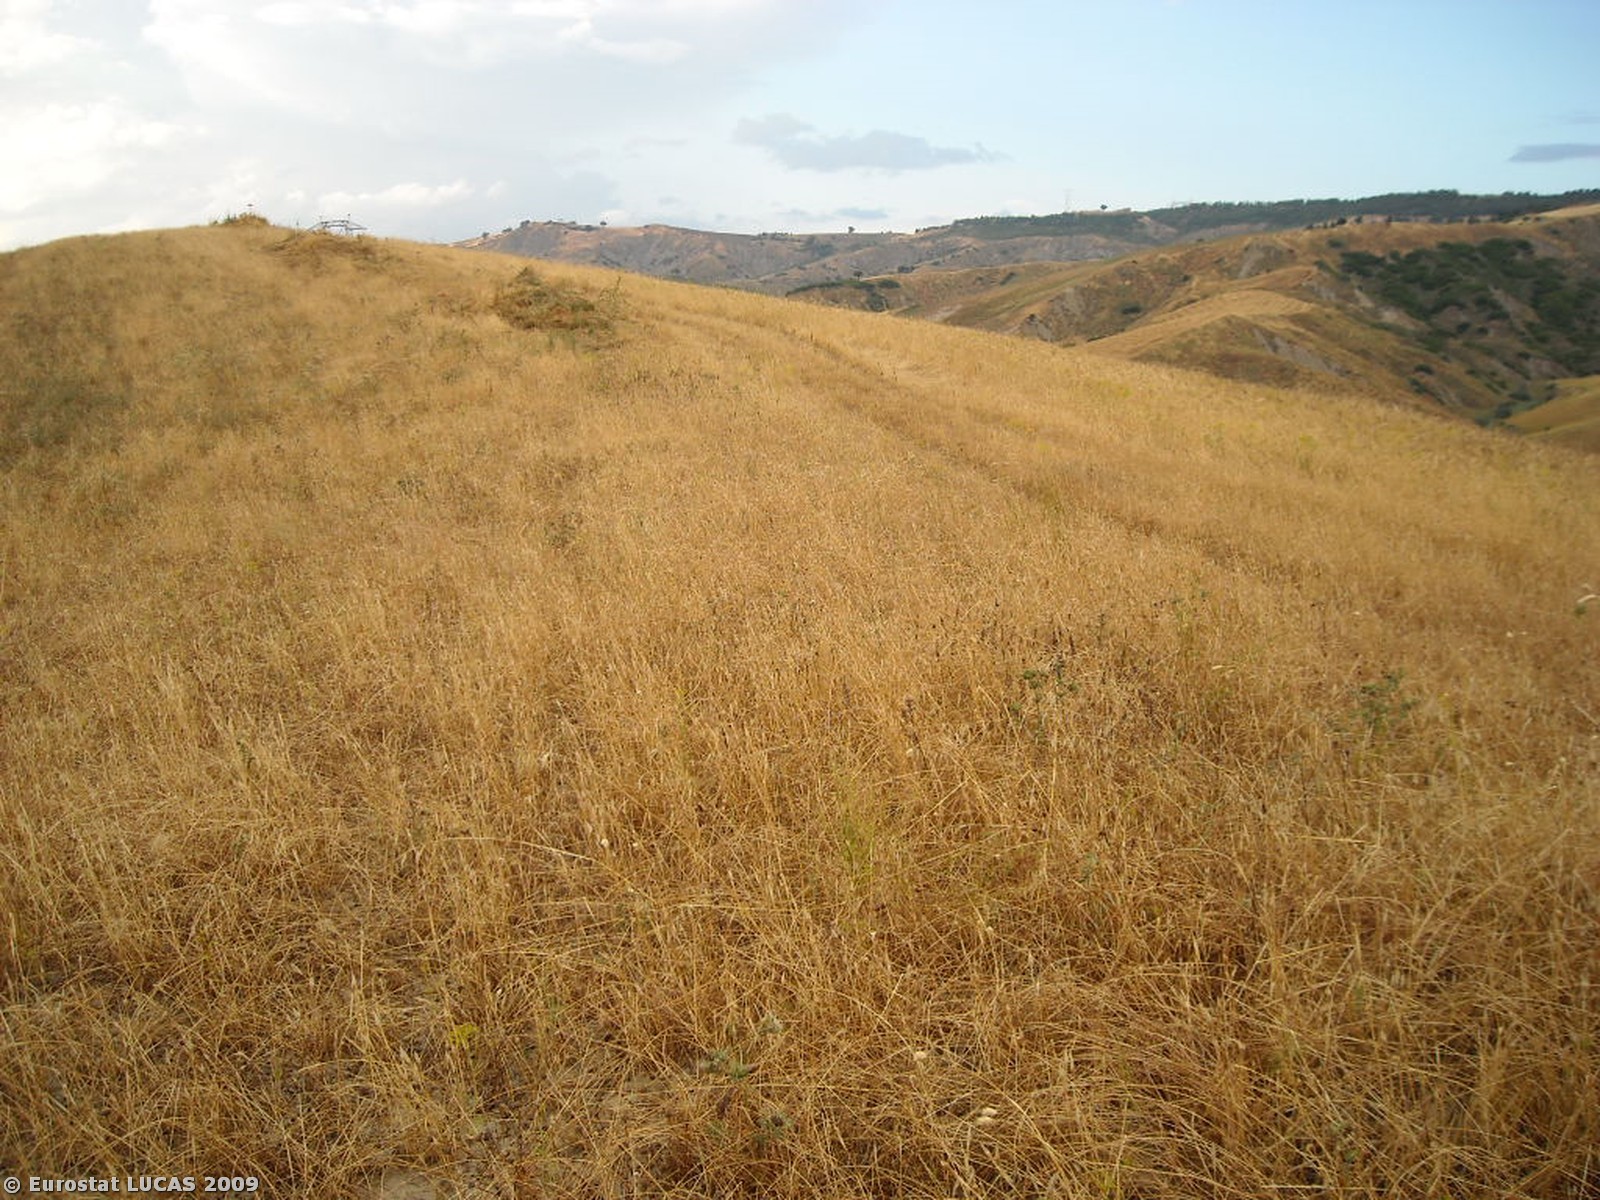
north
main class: Grassland
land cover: Spontaneously vegetated surfaces
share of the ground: > 75 %
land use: Fallow land
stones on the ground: < 10 %
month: June
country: IT
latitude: 40.5370
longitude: 16.2928
